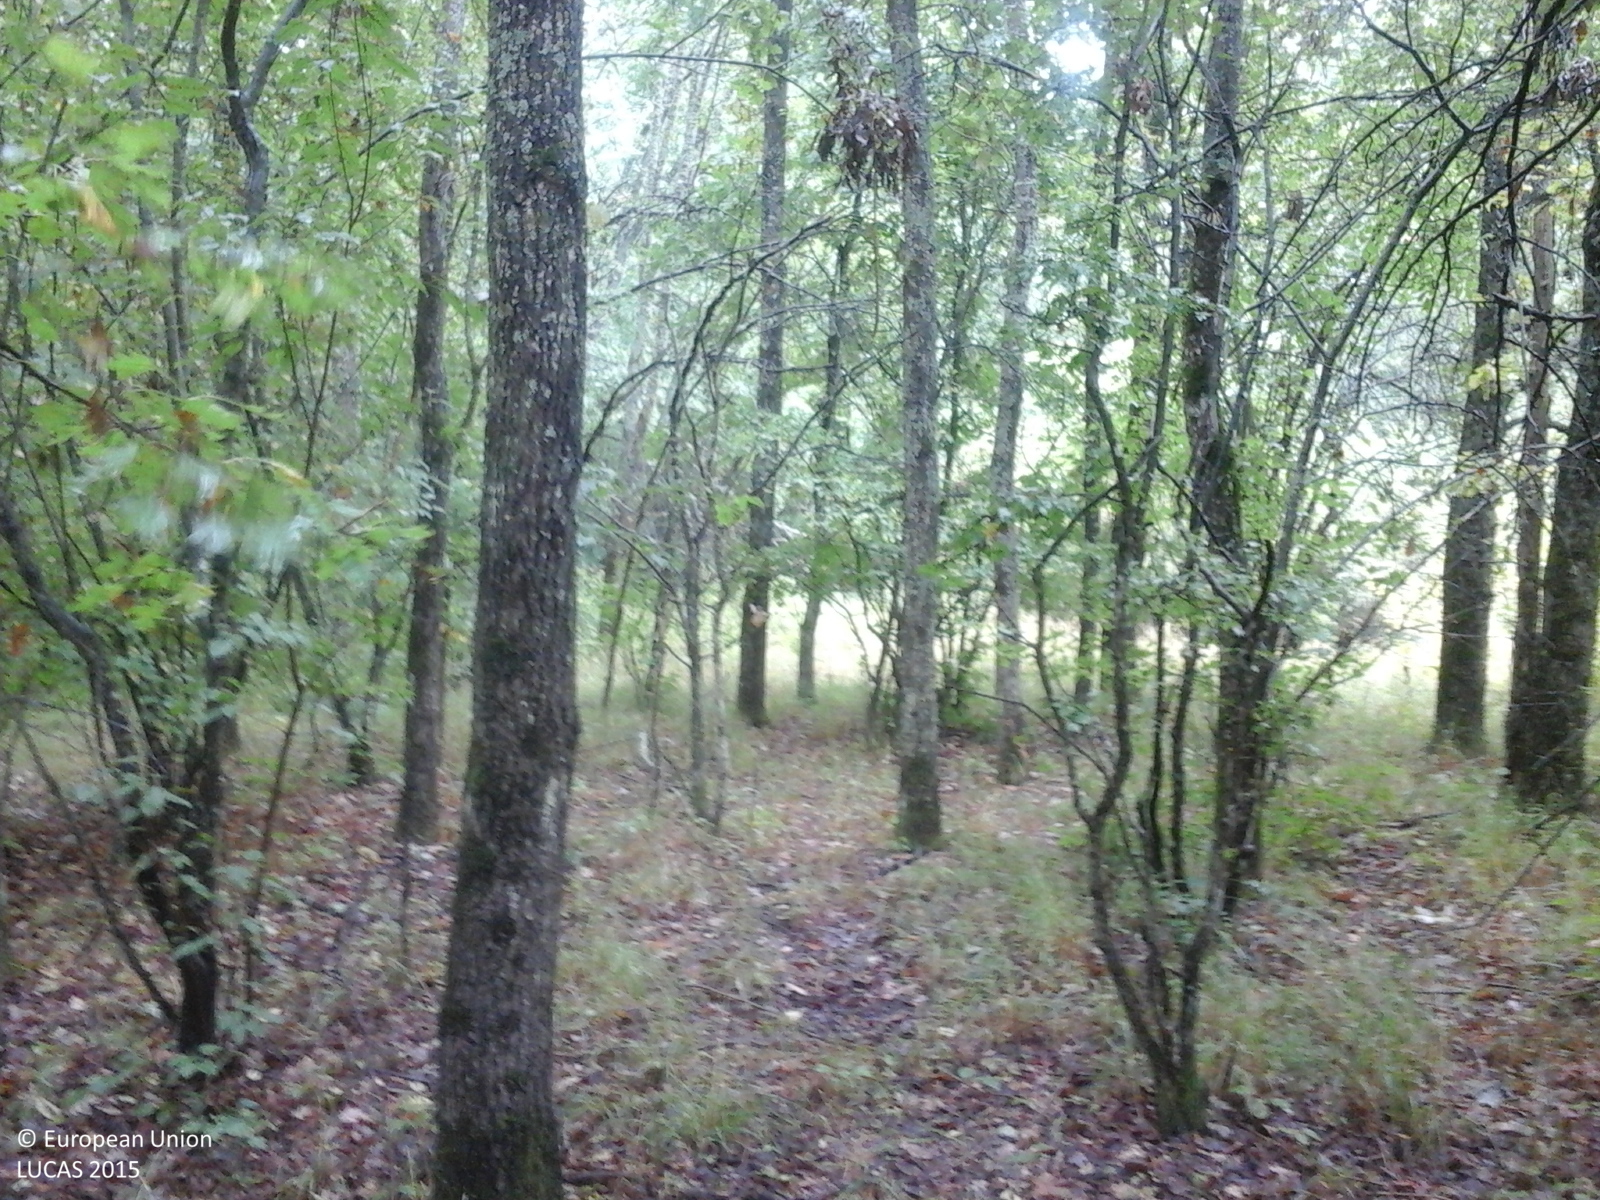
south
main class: Woodland
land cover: Broadleaved woodland
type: acidophilous oak and oak-birch forest
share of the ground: > 75 %
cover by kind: broadleaved forest trees 100 %
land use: Forestry
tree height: > 5 m
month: August
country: RO
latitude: 45.7128
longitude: 21.4792
